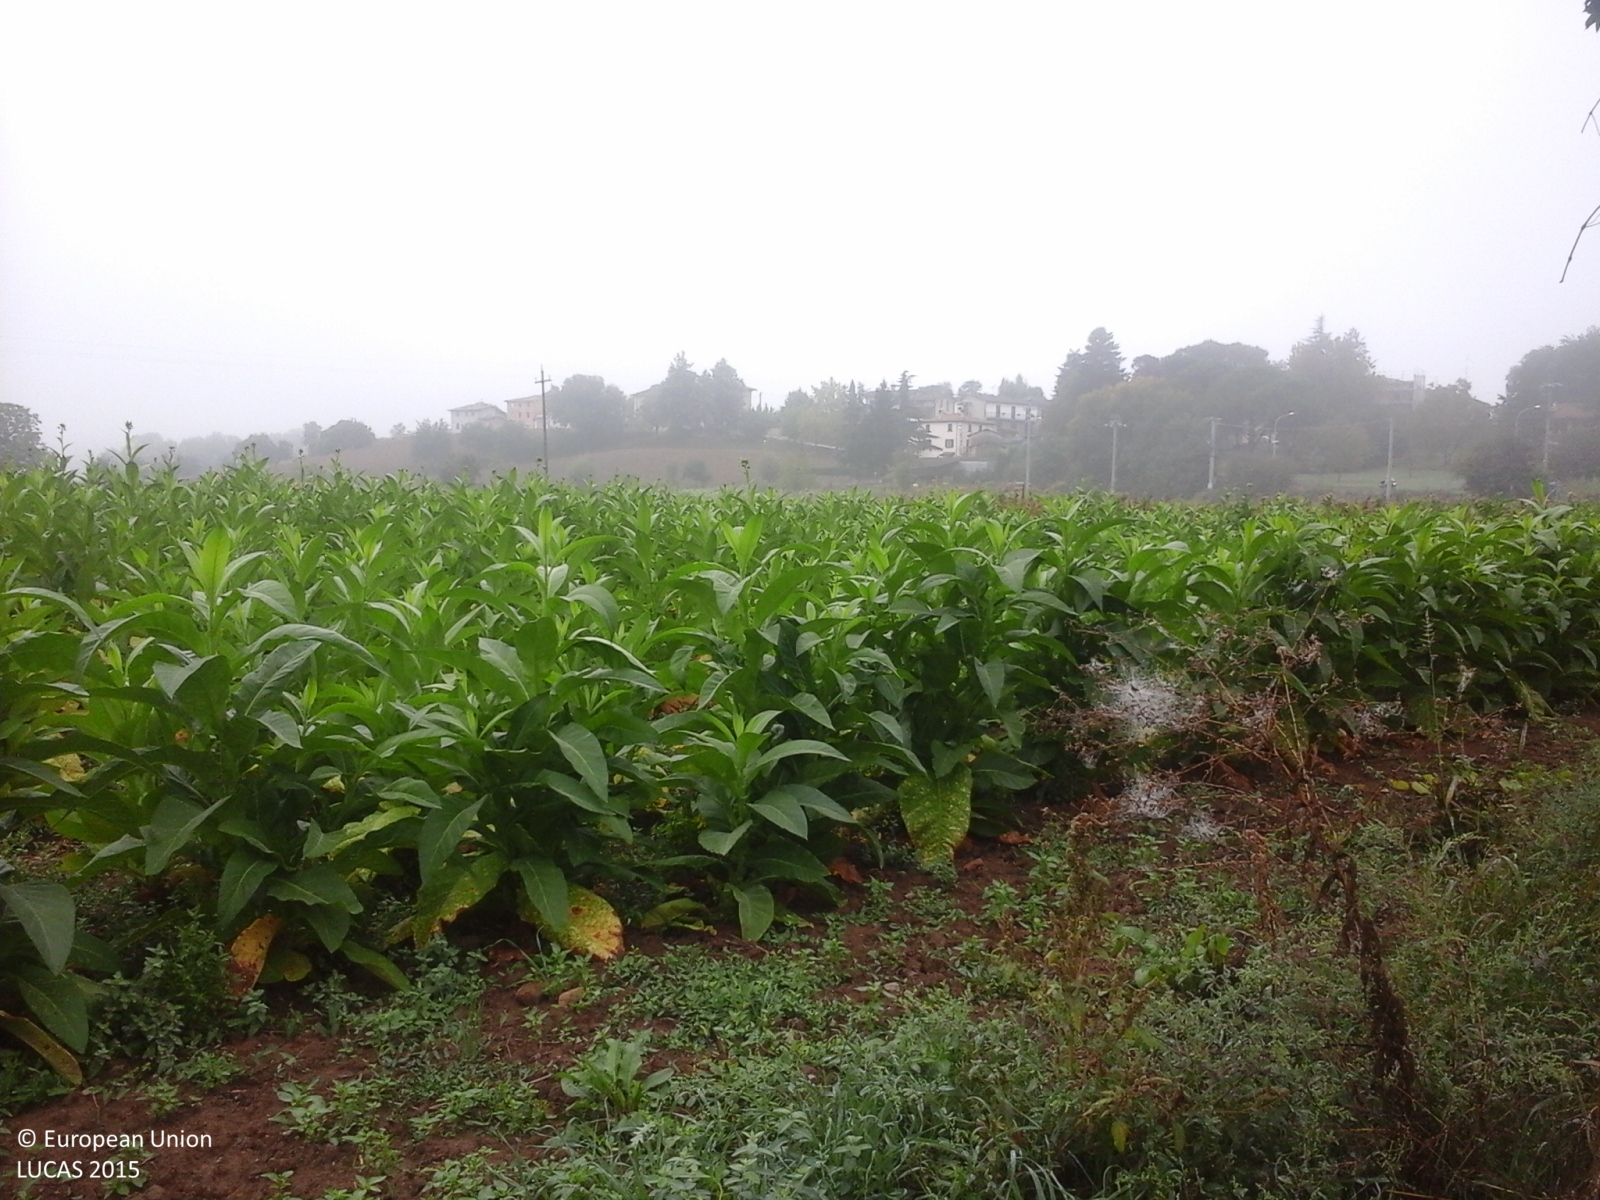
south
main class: Cropland
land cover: Tobacco
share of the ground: > 75 %
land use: Agriculture (excluding fallow land and kitchen gardens)
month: October
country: IT
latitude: 43.5170
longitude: 12.1098
